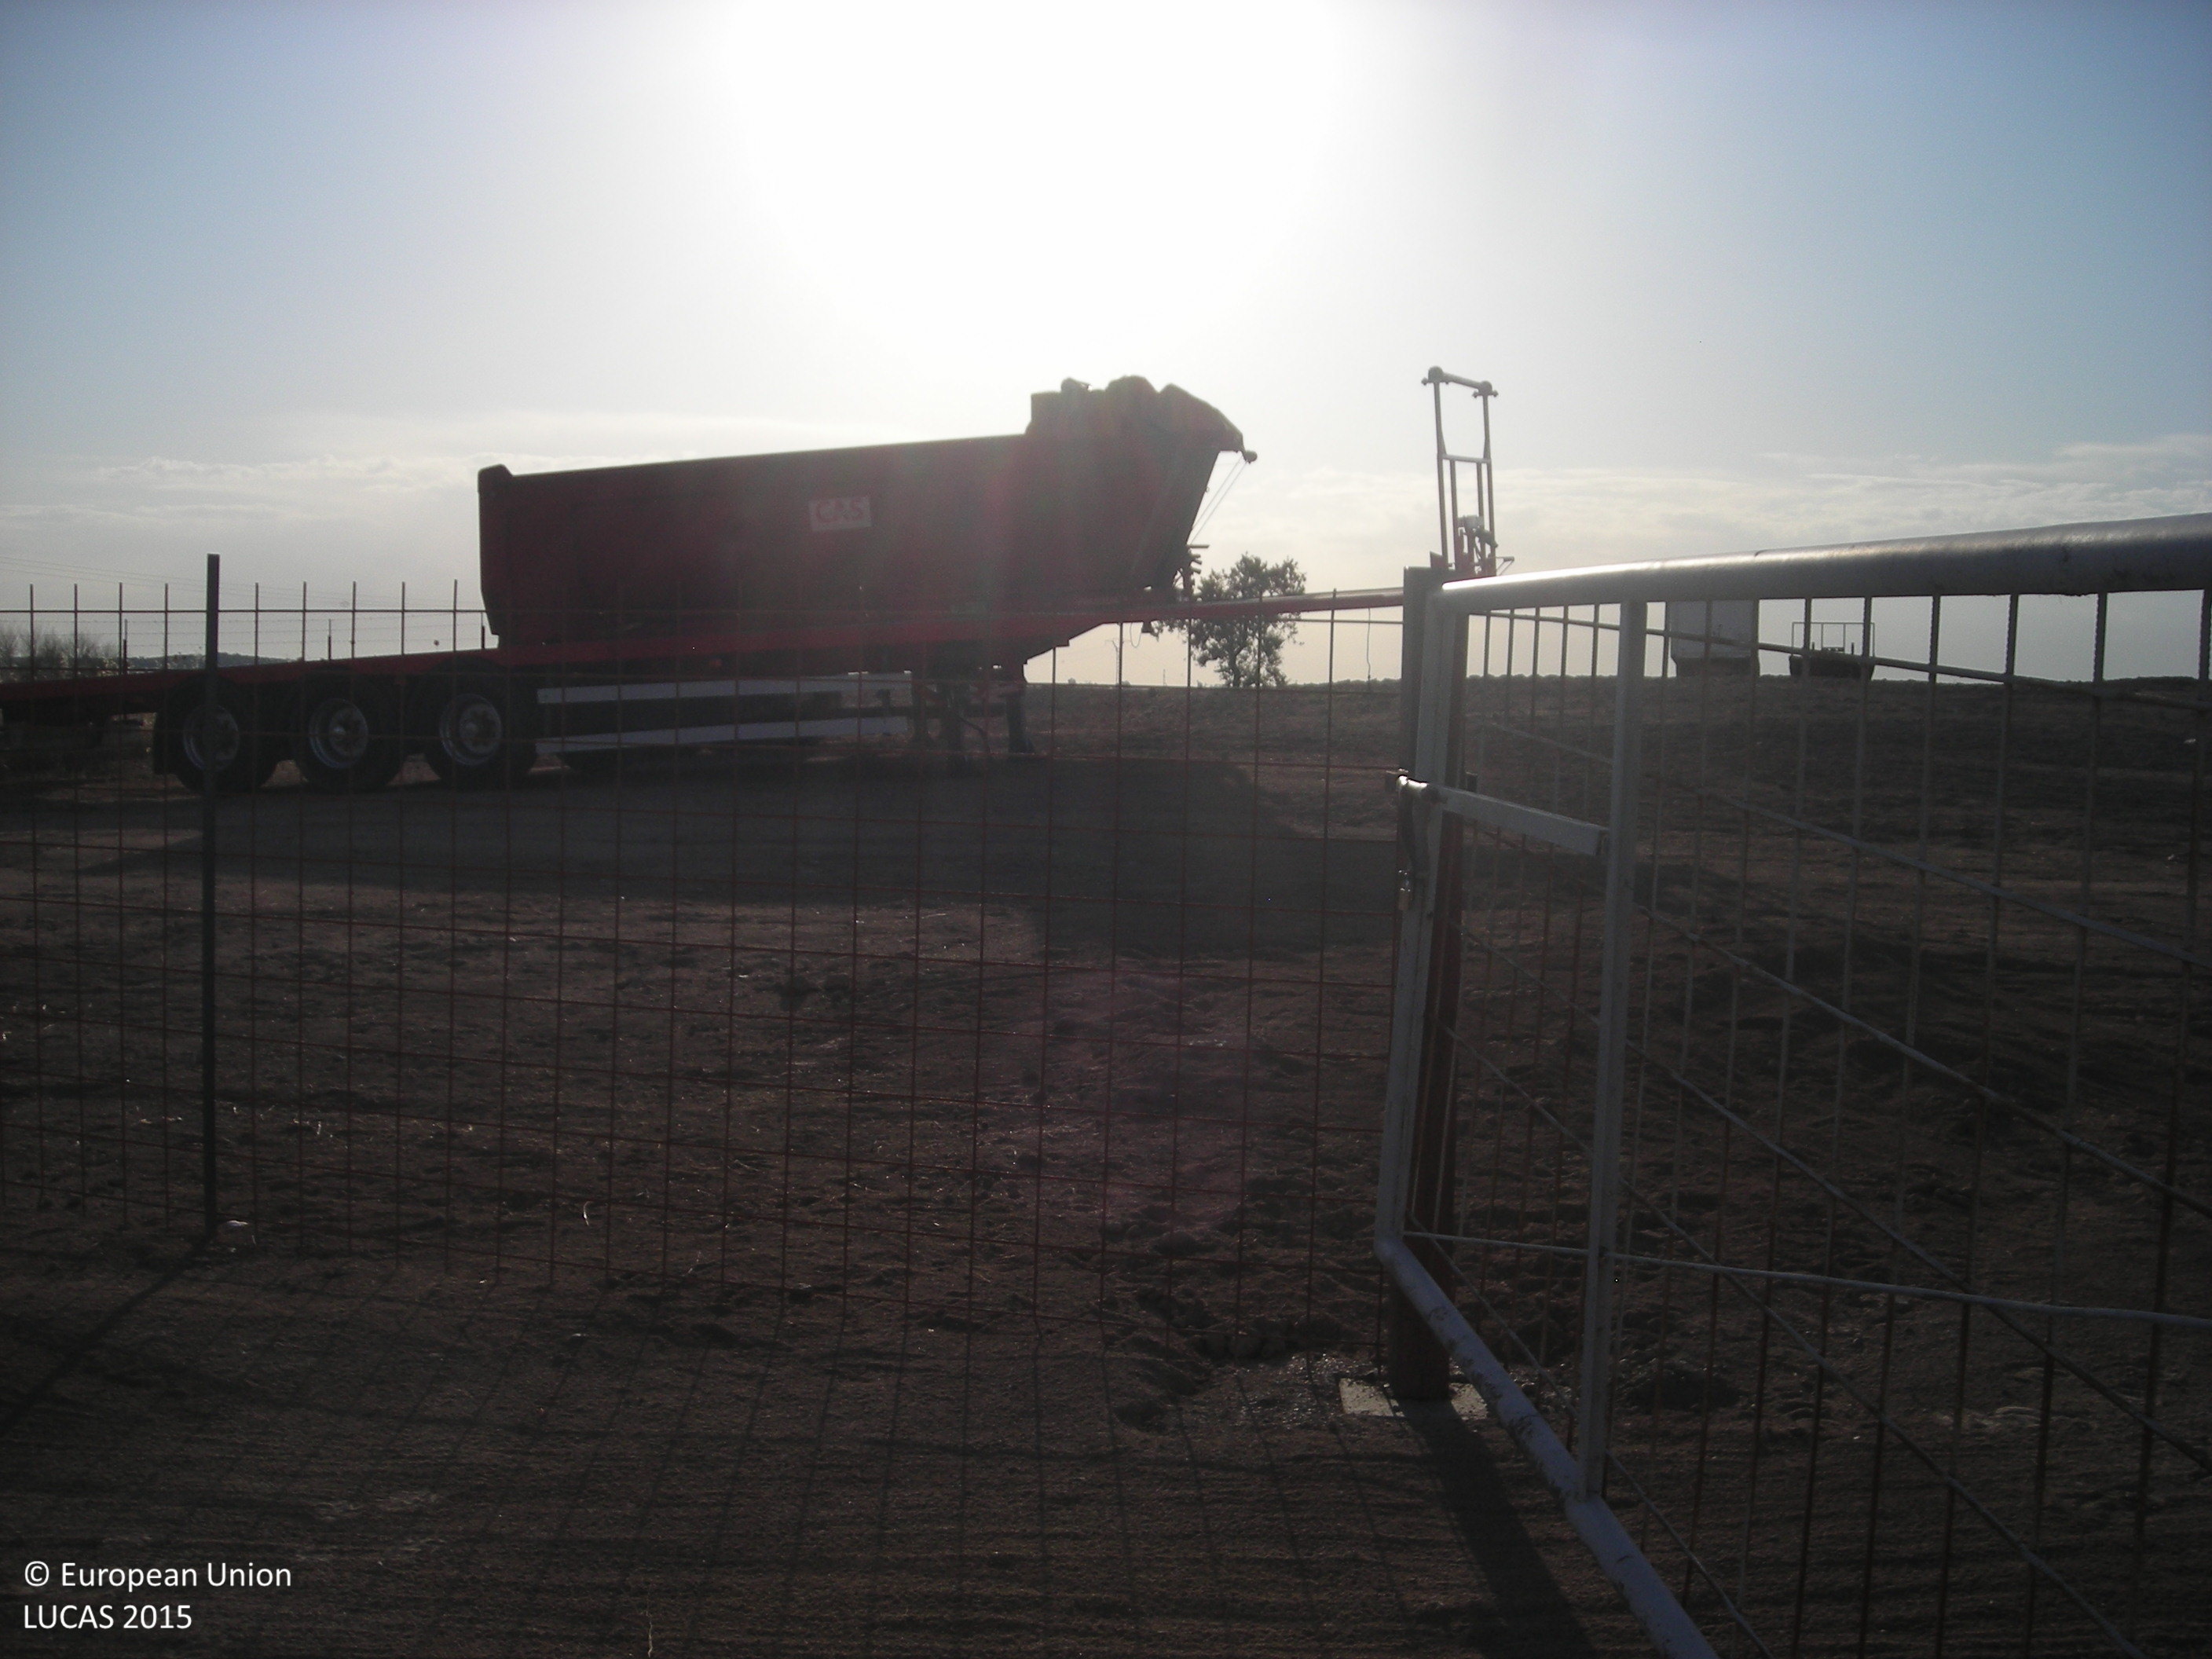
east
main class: Grassland
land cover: Spontaneously vegetated surfaces
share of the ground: > 75 %
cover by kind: herbaceous plants 100 %
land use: Agriculture (excluding fallow land and kitchen gardens)
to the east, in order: Spontaneously vegetated surfaces; Fences; Dry stone walls; Grassland without tree/shrub cover; Tracks; Artificial constructions in urban areas; Grassland without tree/shrub cover; Artificial constructions in urban areas; Grassland without tree/shrub cover
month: July
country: ES
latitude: 39.1352
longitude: -5.9612
